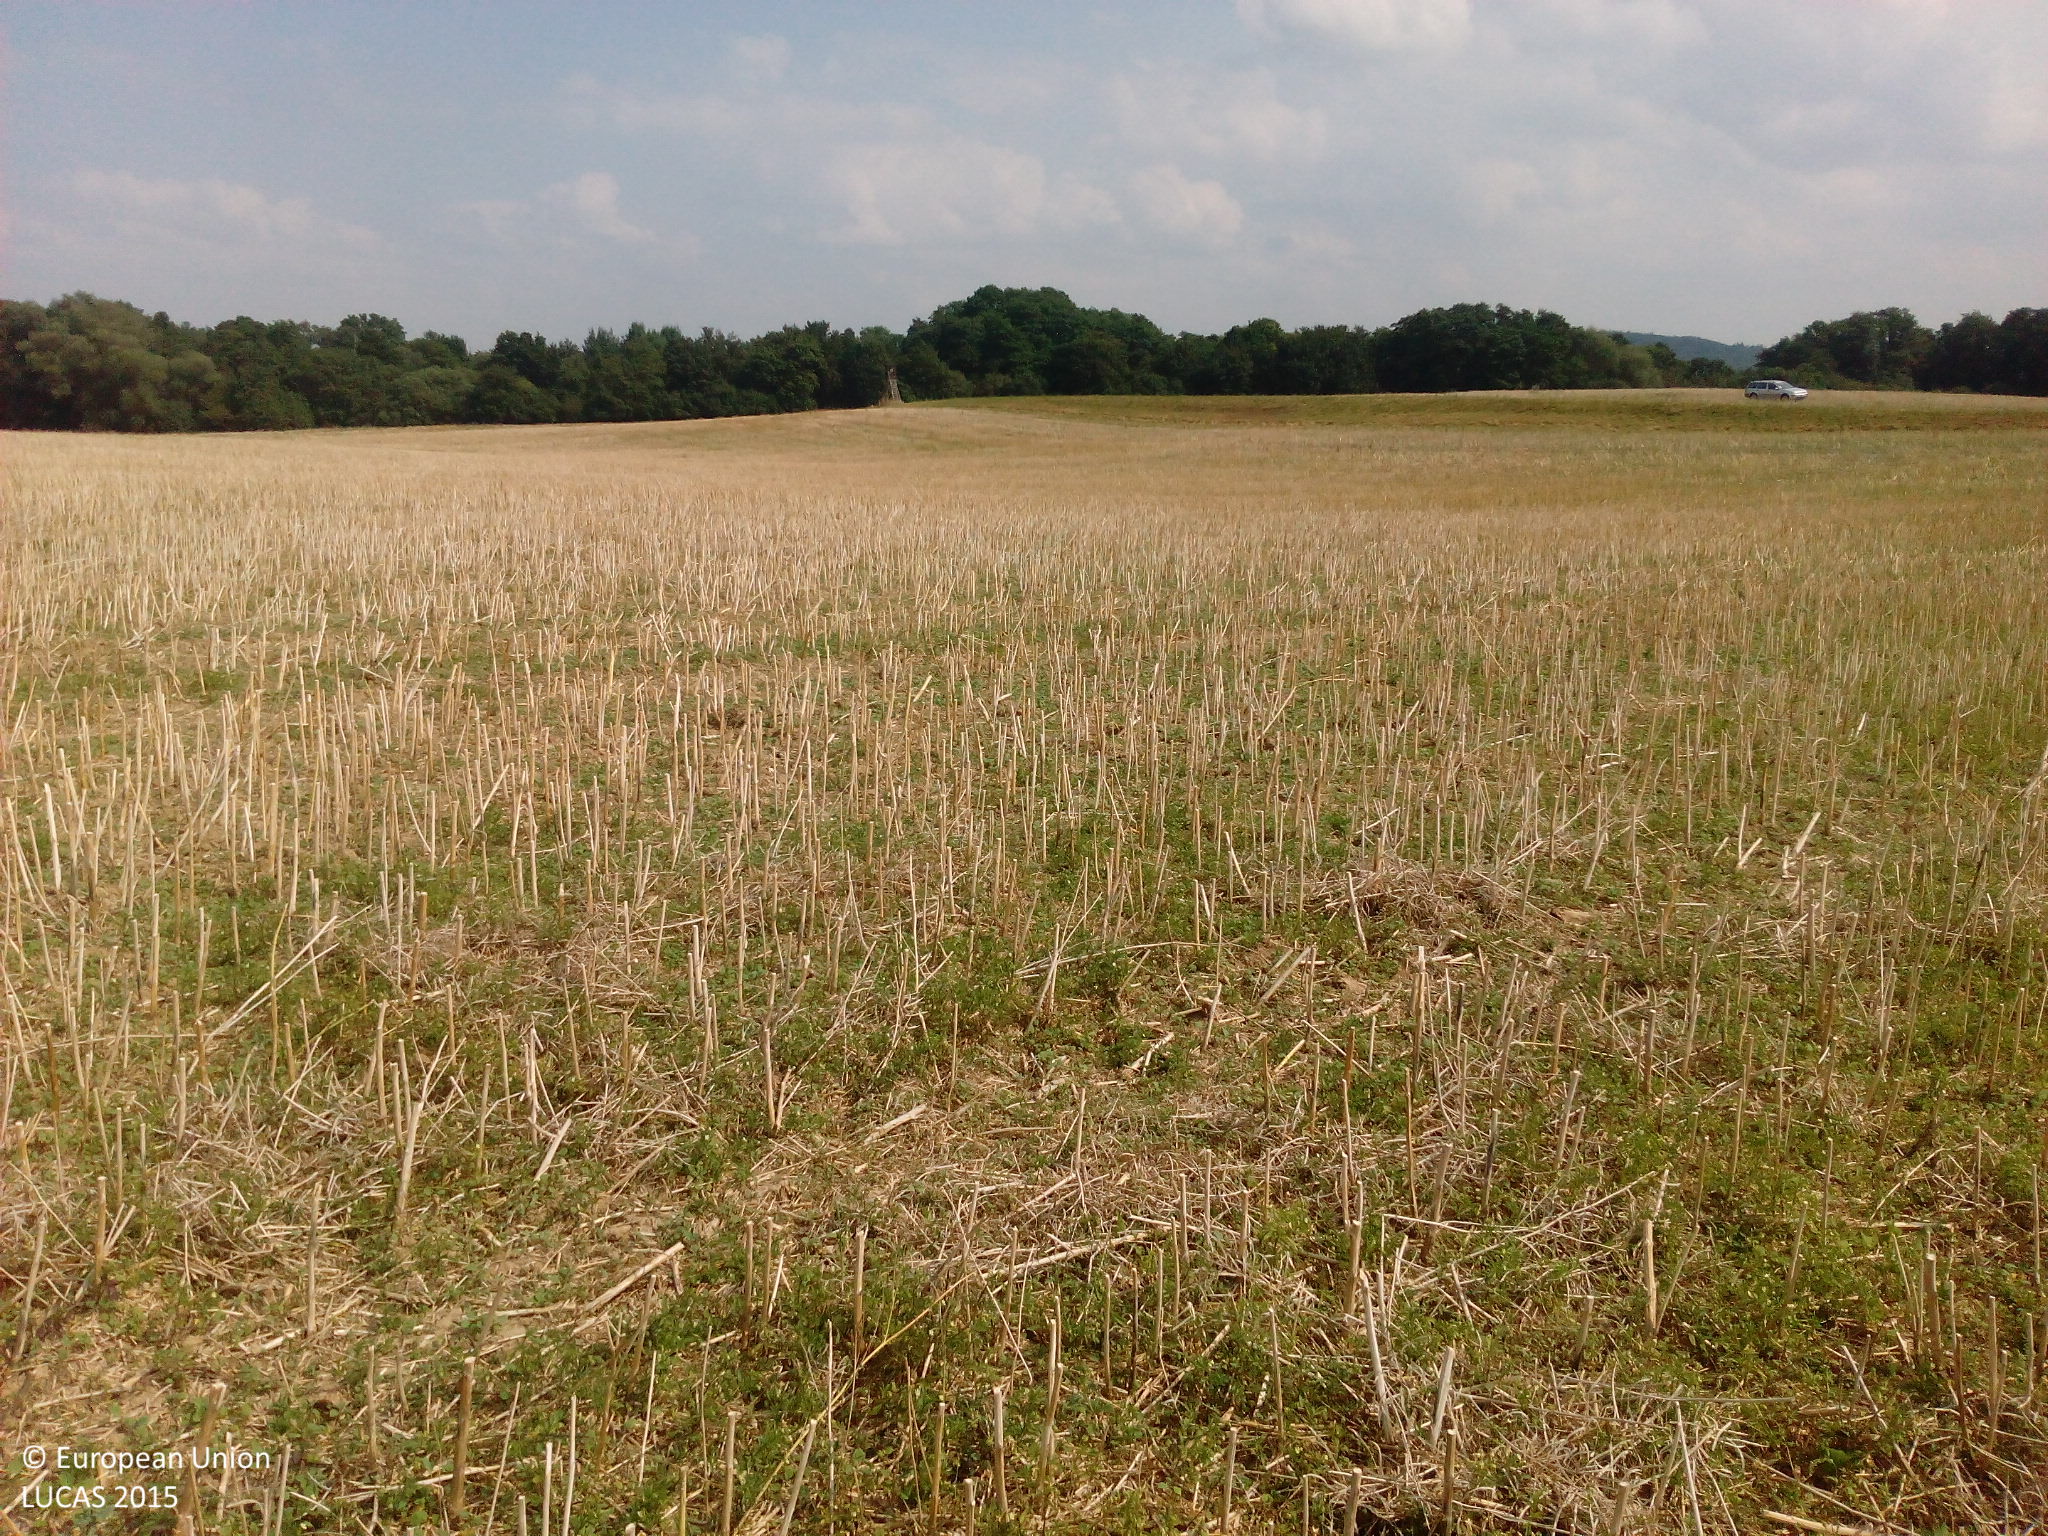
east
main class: Cropland
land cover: Rape and turnip rape
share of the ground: < 10 %
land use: Agriculture (excluding fallow land and kitchen gardens)
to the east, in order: Rape and turnip rape; Grassland without tree/shrub cover; Rape and turnip rape
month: August
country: DE
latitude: 53.6973
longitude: 12.6195
